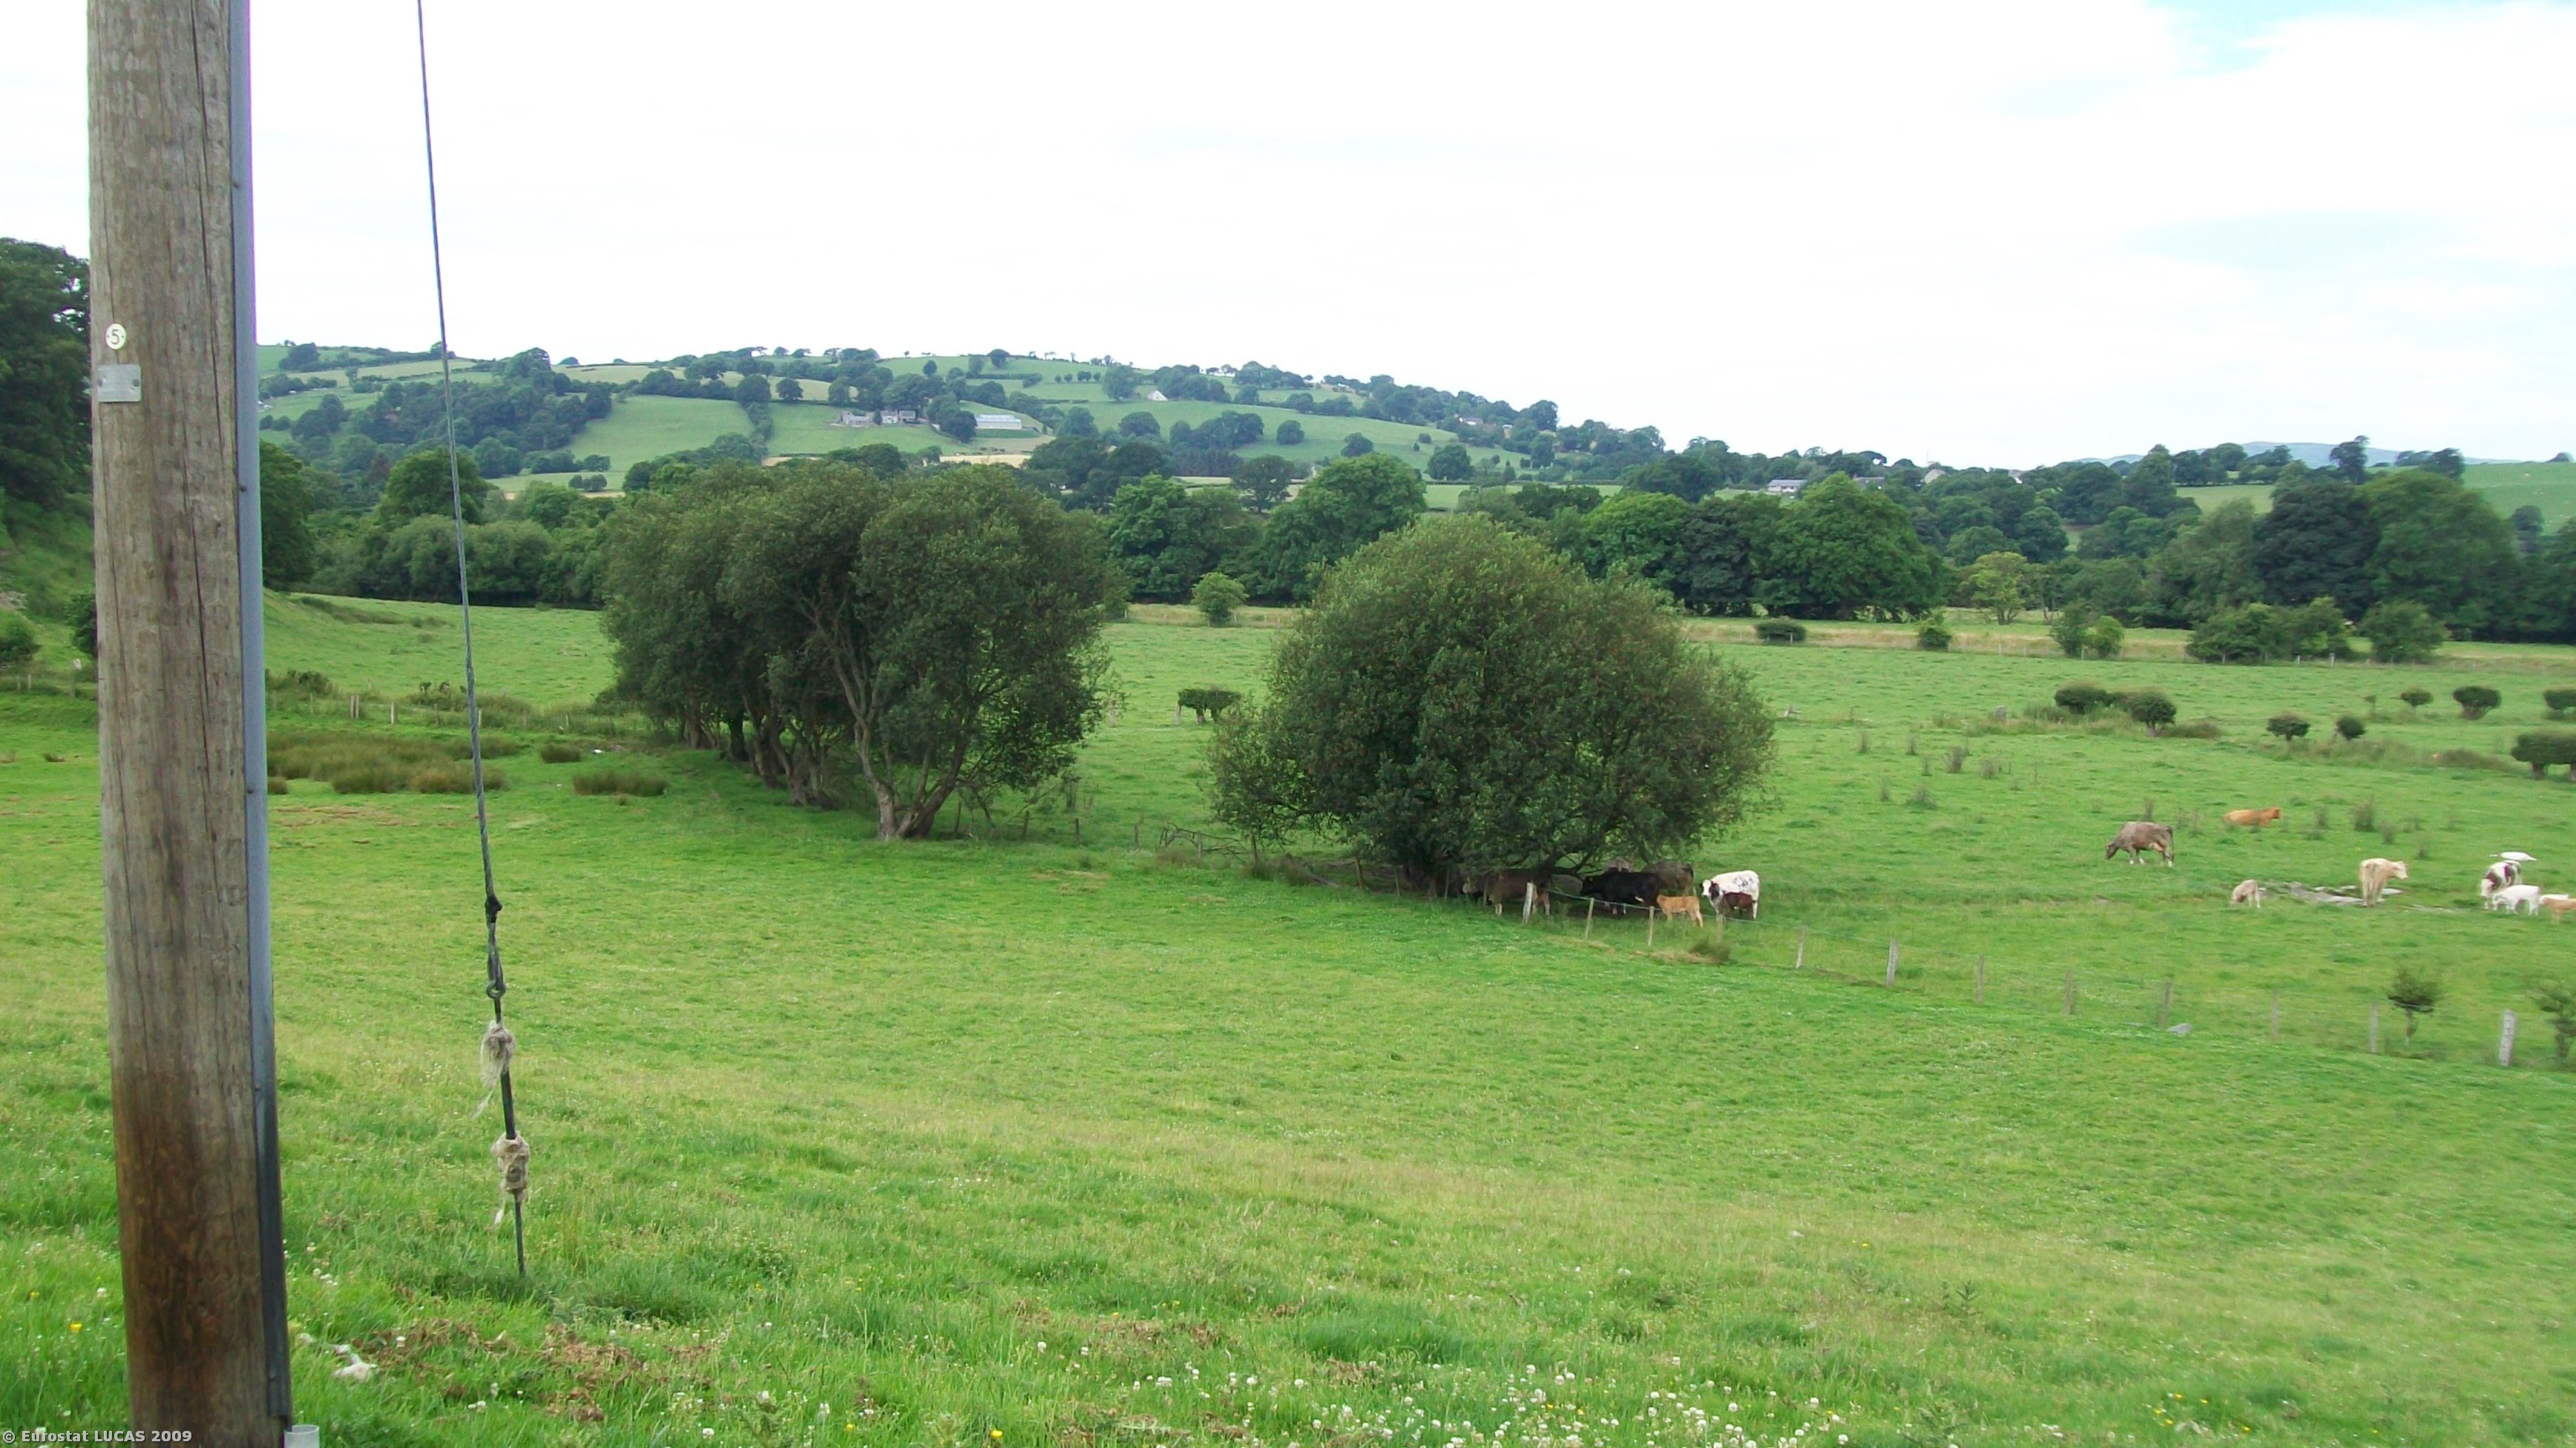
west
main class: Grassland
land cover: Grassland without tree/shrub cover
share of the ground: > 75 %
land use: Agriculture (excluding fallow land and kitchen gardens)
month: July
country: GB
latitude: 52.9620
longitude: -3.4066
